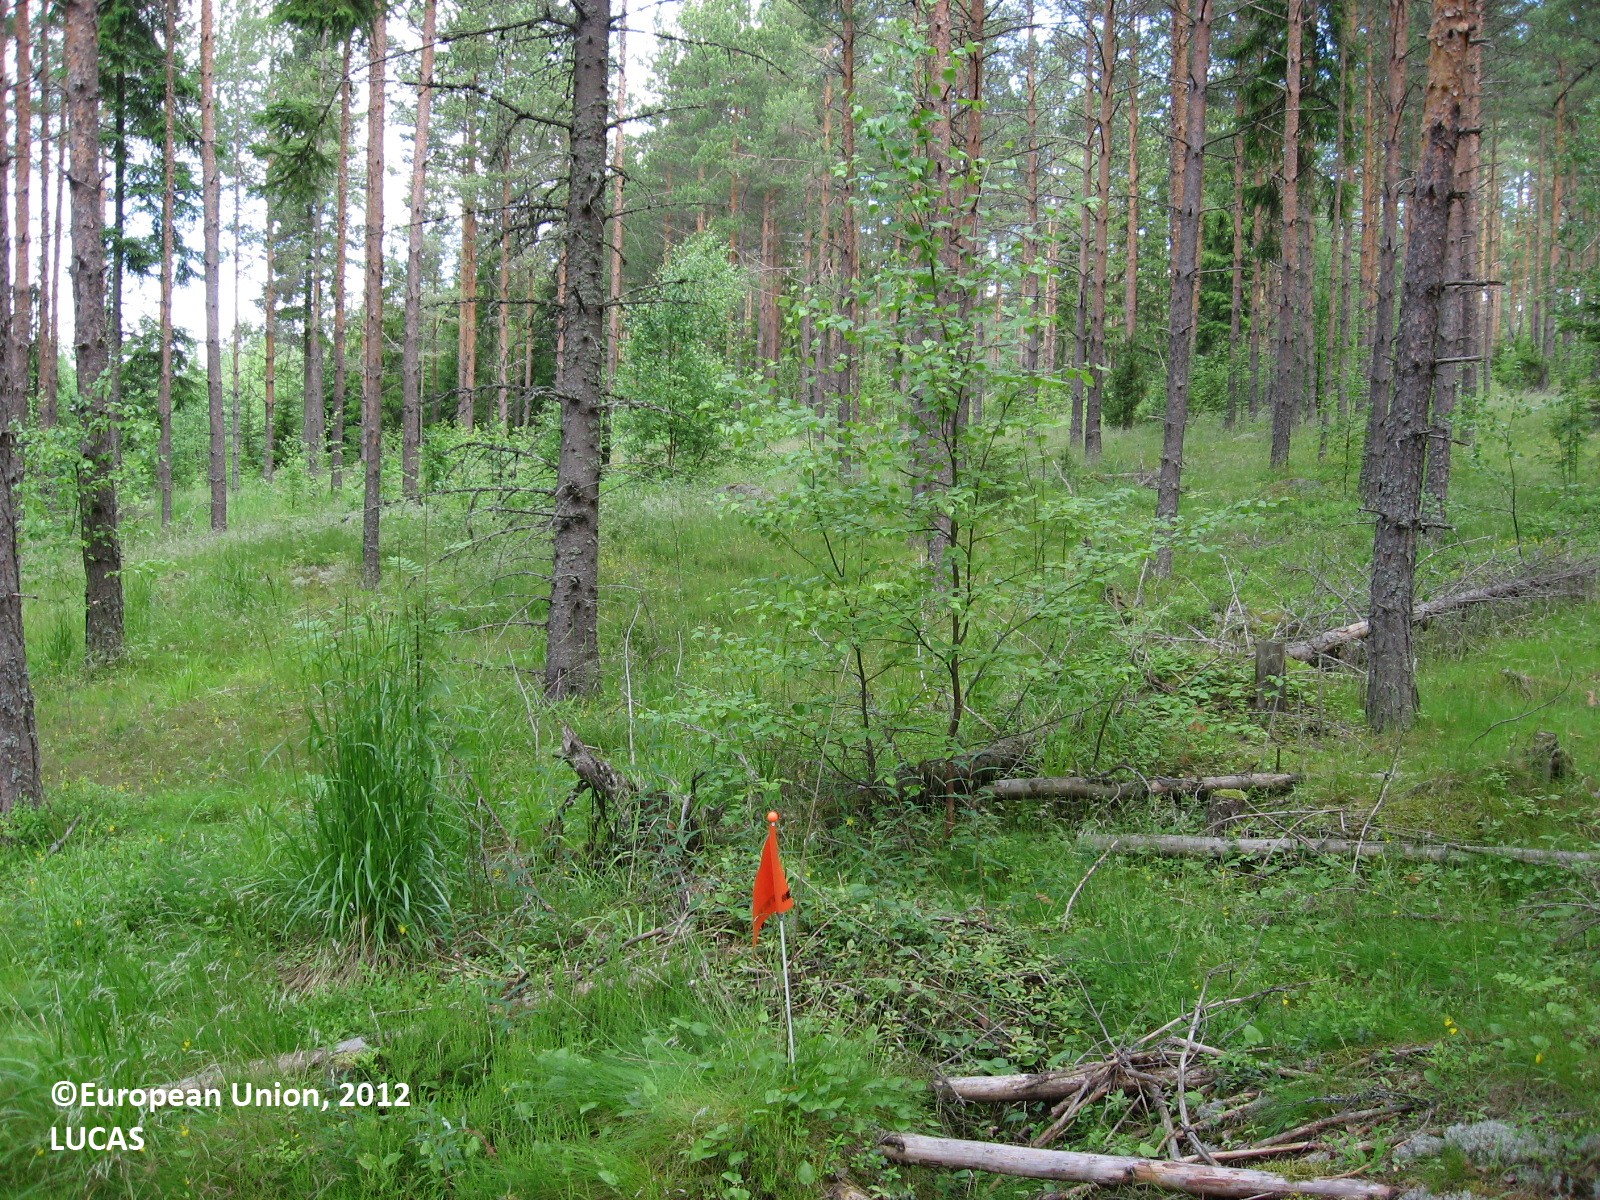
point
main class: Woodland
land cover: Pine dominated coniferous woodland
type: boreal forest
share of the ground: 25 - 50 %
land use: Forestry
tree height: > 5 m
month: June
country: FI
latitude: 60.6926
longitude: 26.5093
